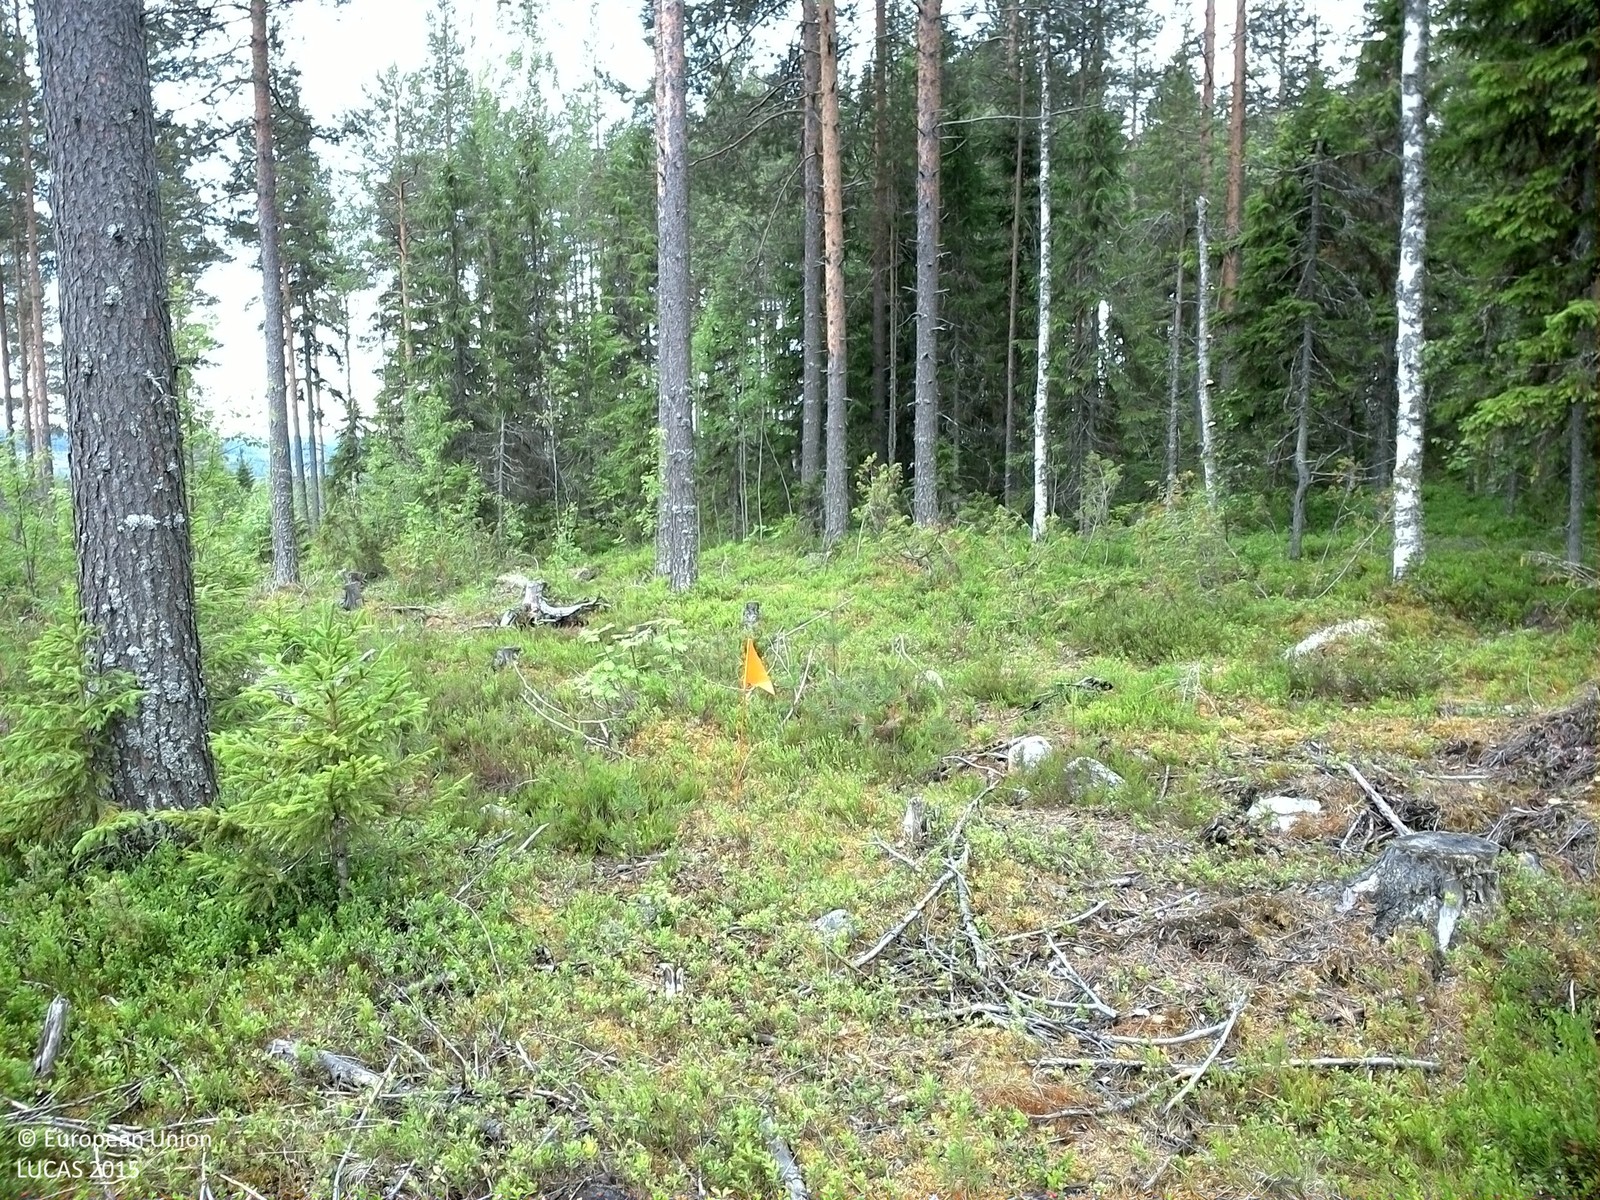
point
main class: Woodland
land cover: Pine dominated mixed woodland
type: boreal forest
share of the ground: 50 - 75 %
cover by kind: coniferous forest trees 35 %, shrubs 30 %, broadleaved forest trees 25 %, herbaceous plants 5 %, lichens and mosses 5 %
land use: Forestry
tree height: > 5 m
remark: Clear cut
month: July
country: SE
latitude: 63.5328
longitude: 18.5230
